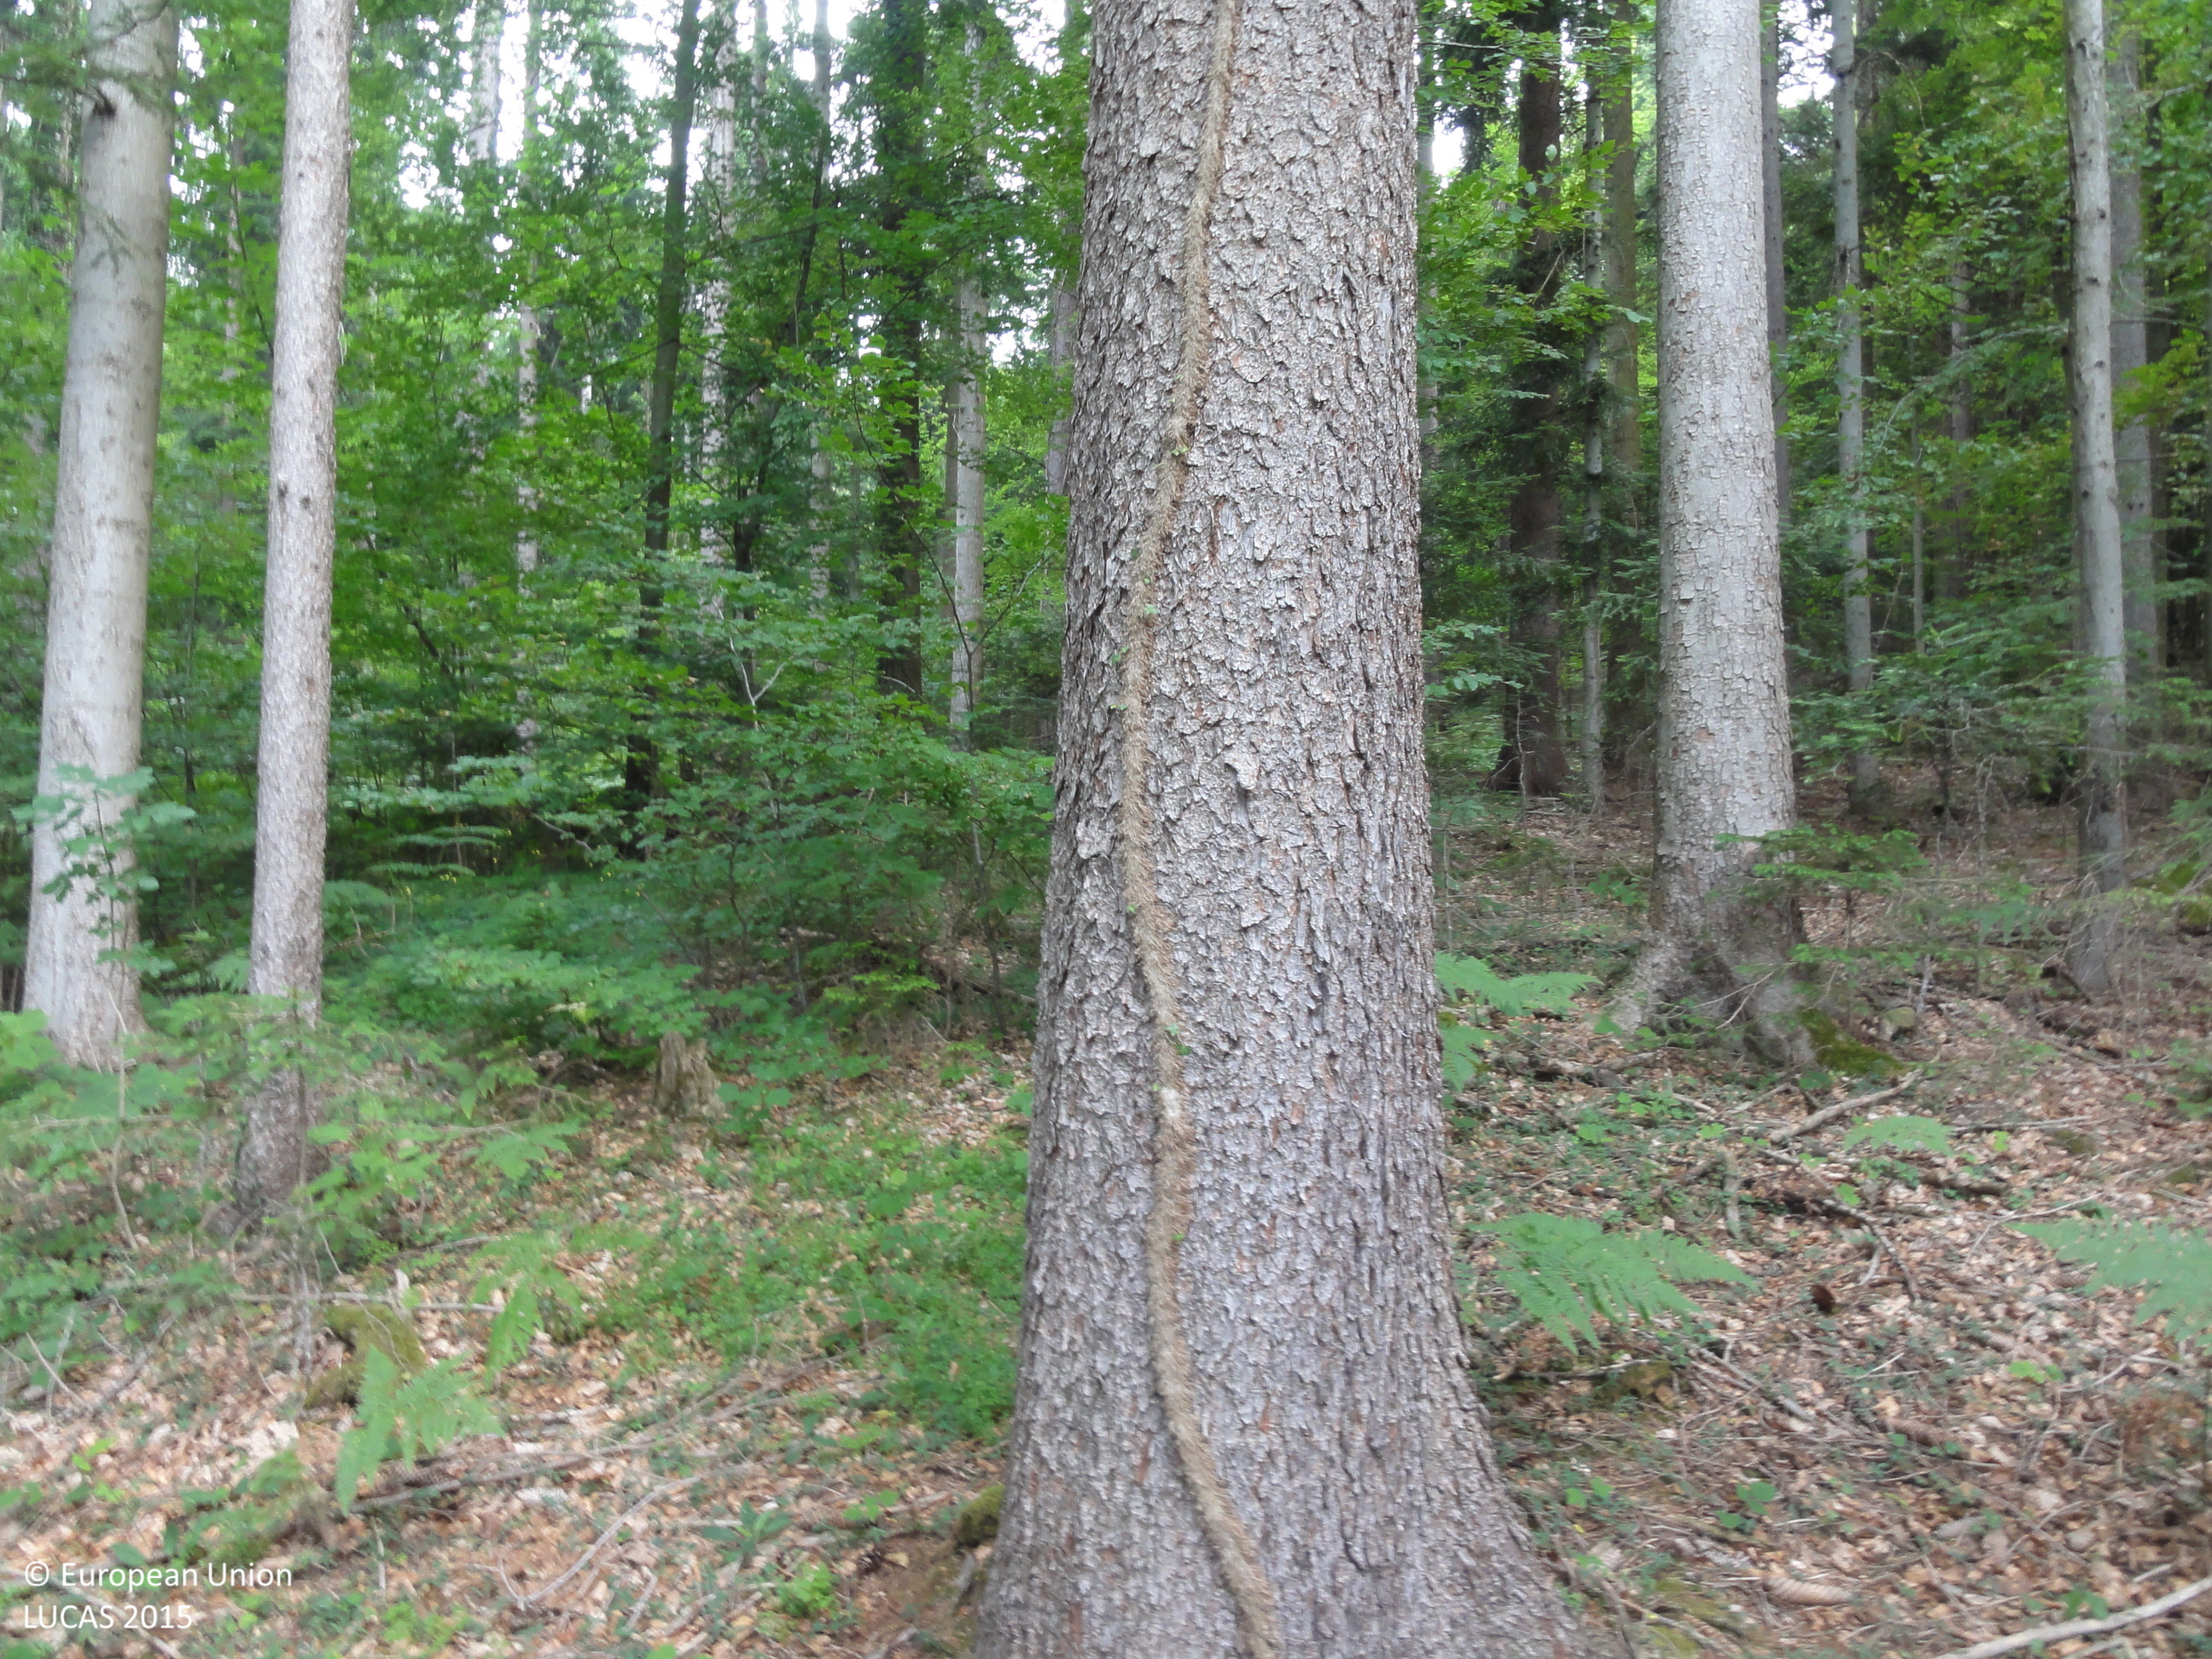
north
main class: Woodland
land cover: Spruce dominated mixed woodland
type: mountainous beech forest
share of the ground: > 75 %
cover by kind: coniferous forest trees 65 %, broadleaved forest trees 30 %, shrubs 5 %
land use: Forestry
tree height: > 5 m
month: June
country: SI
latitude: 46.3306
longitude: 14.8686
